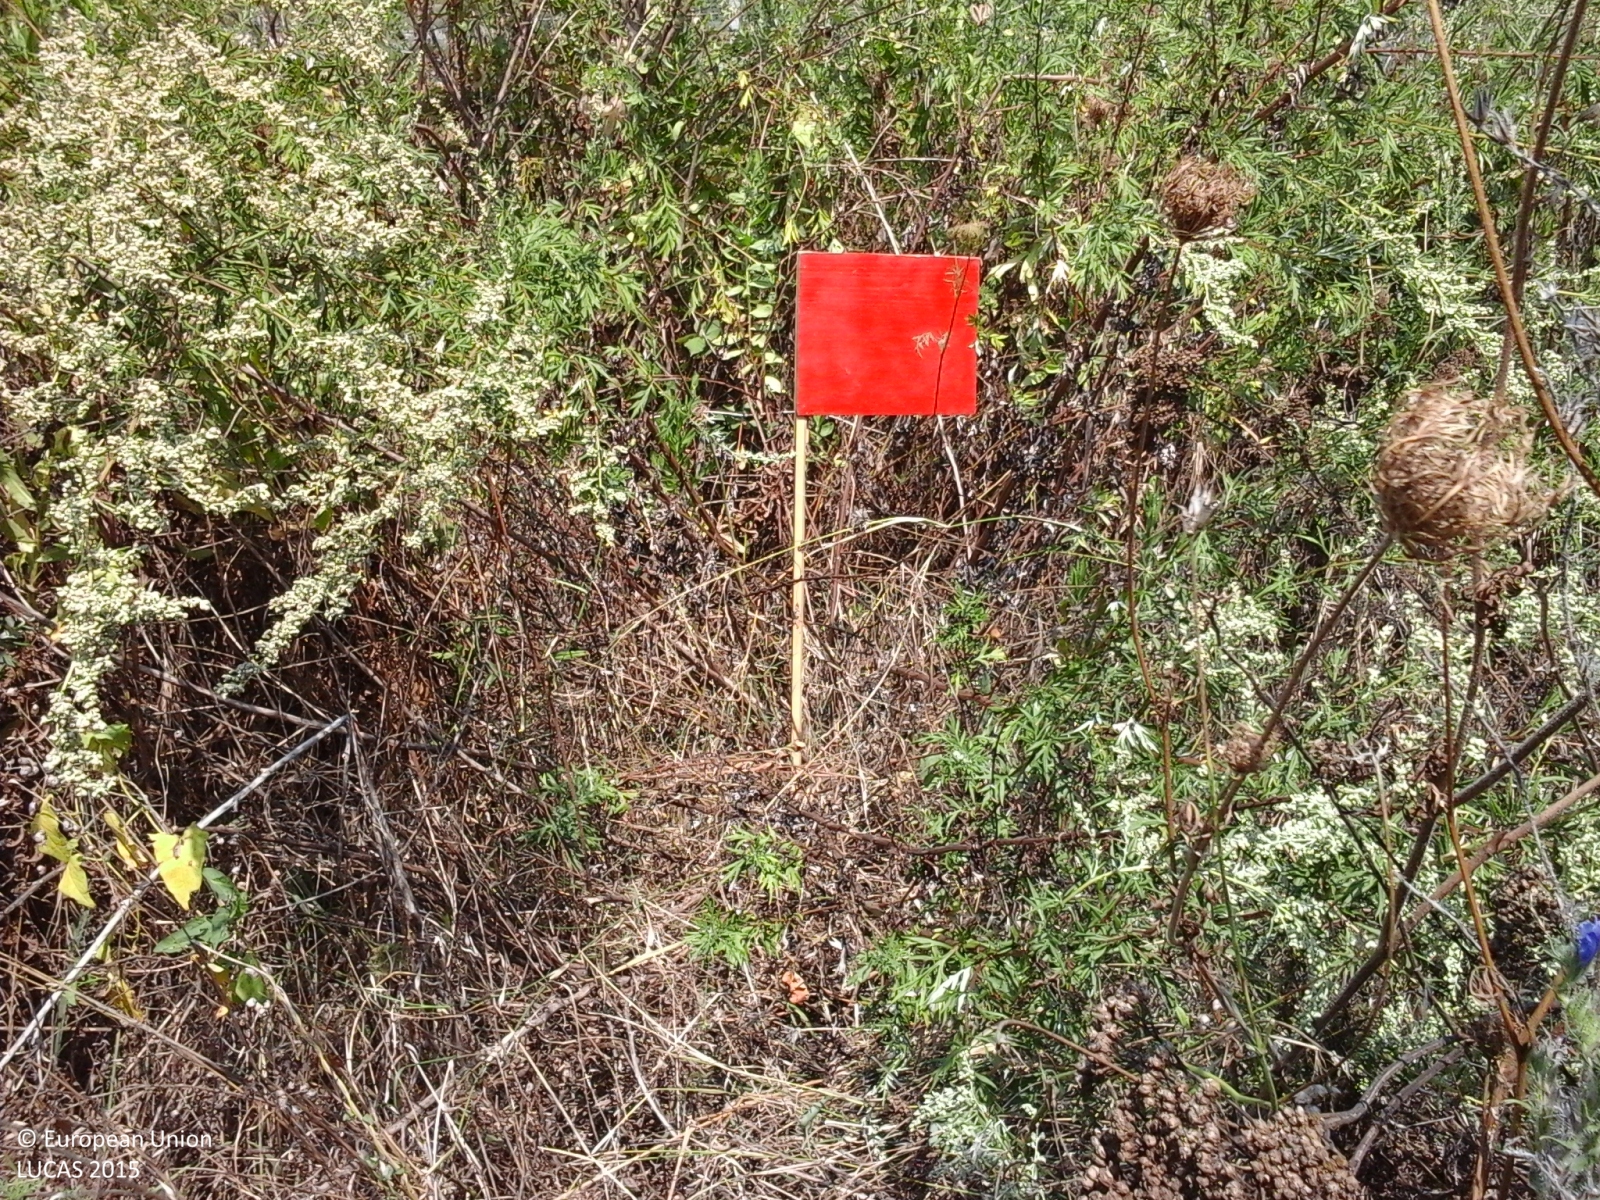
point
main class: Shrubland
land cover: Shrubland without tree cover
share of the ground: > 75 %
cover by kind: shrubs 50 %, herbaceous plants 50 %
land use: Fallow land
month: August
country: IT
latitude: 40.8100
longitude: 14.6398
